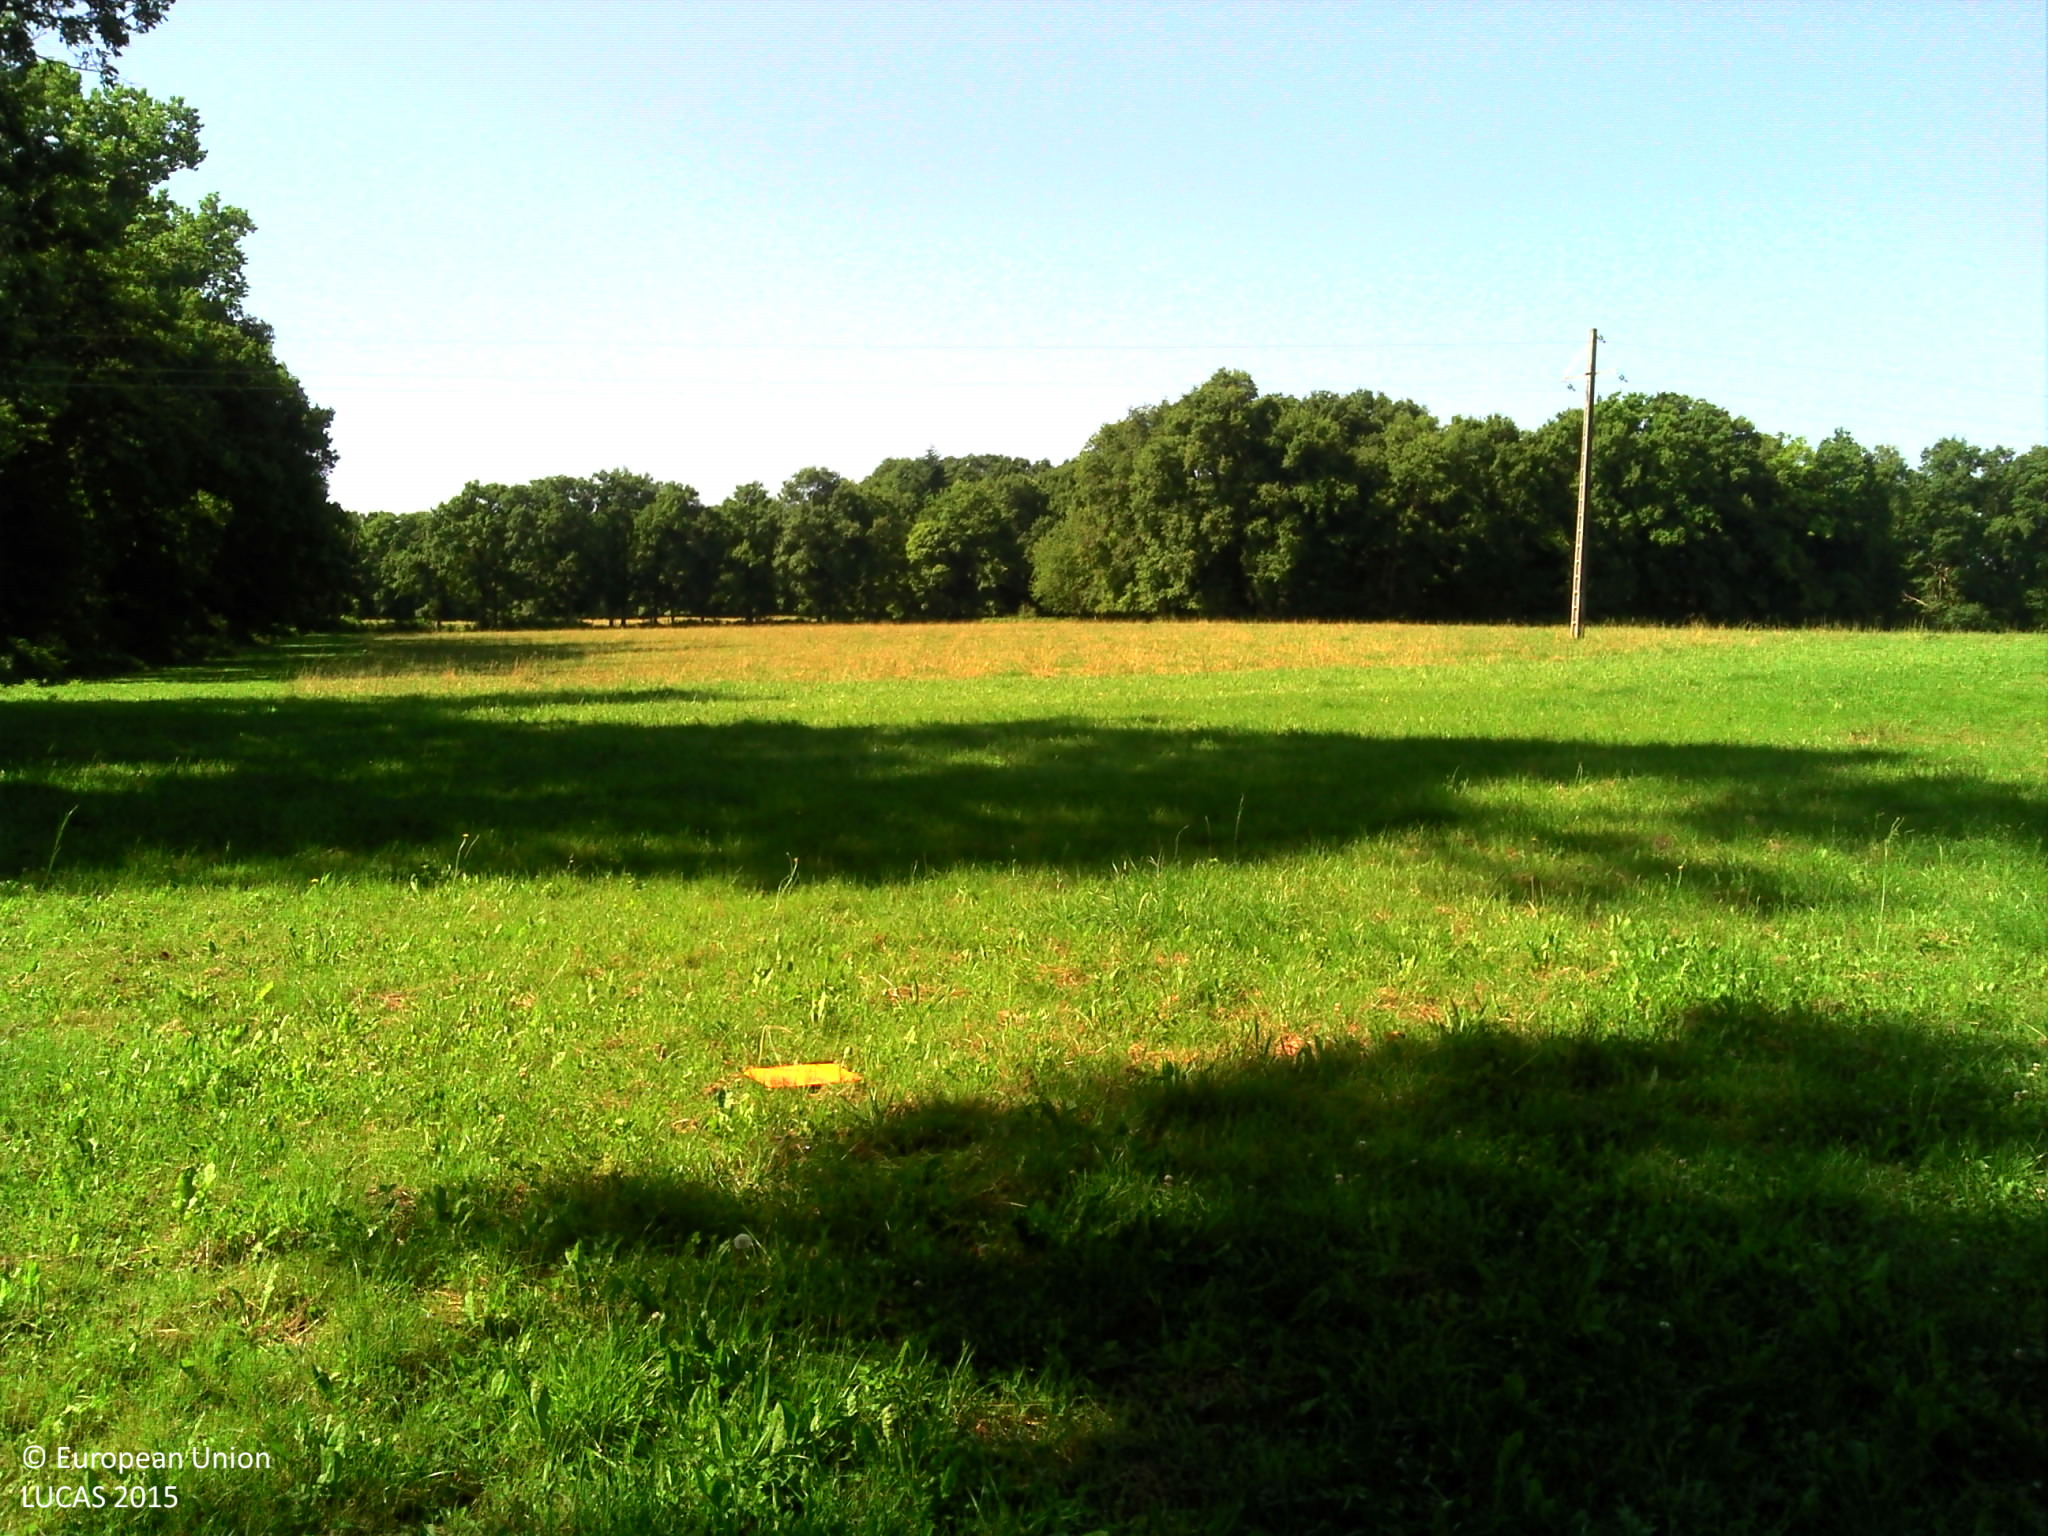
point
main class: Grassland
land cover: Grassland without tree/shrub cover
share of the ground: > 75 %
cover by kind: herbaceous plants 100 %
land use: Agriculture (excluding fallow land and kitchen gardens)
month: June
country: FR
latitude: 45.9015
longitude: 0.6153
